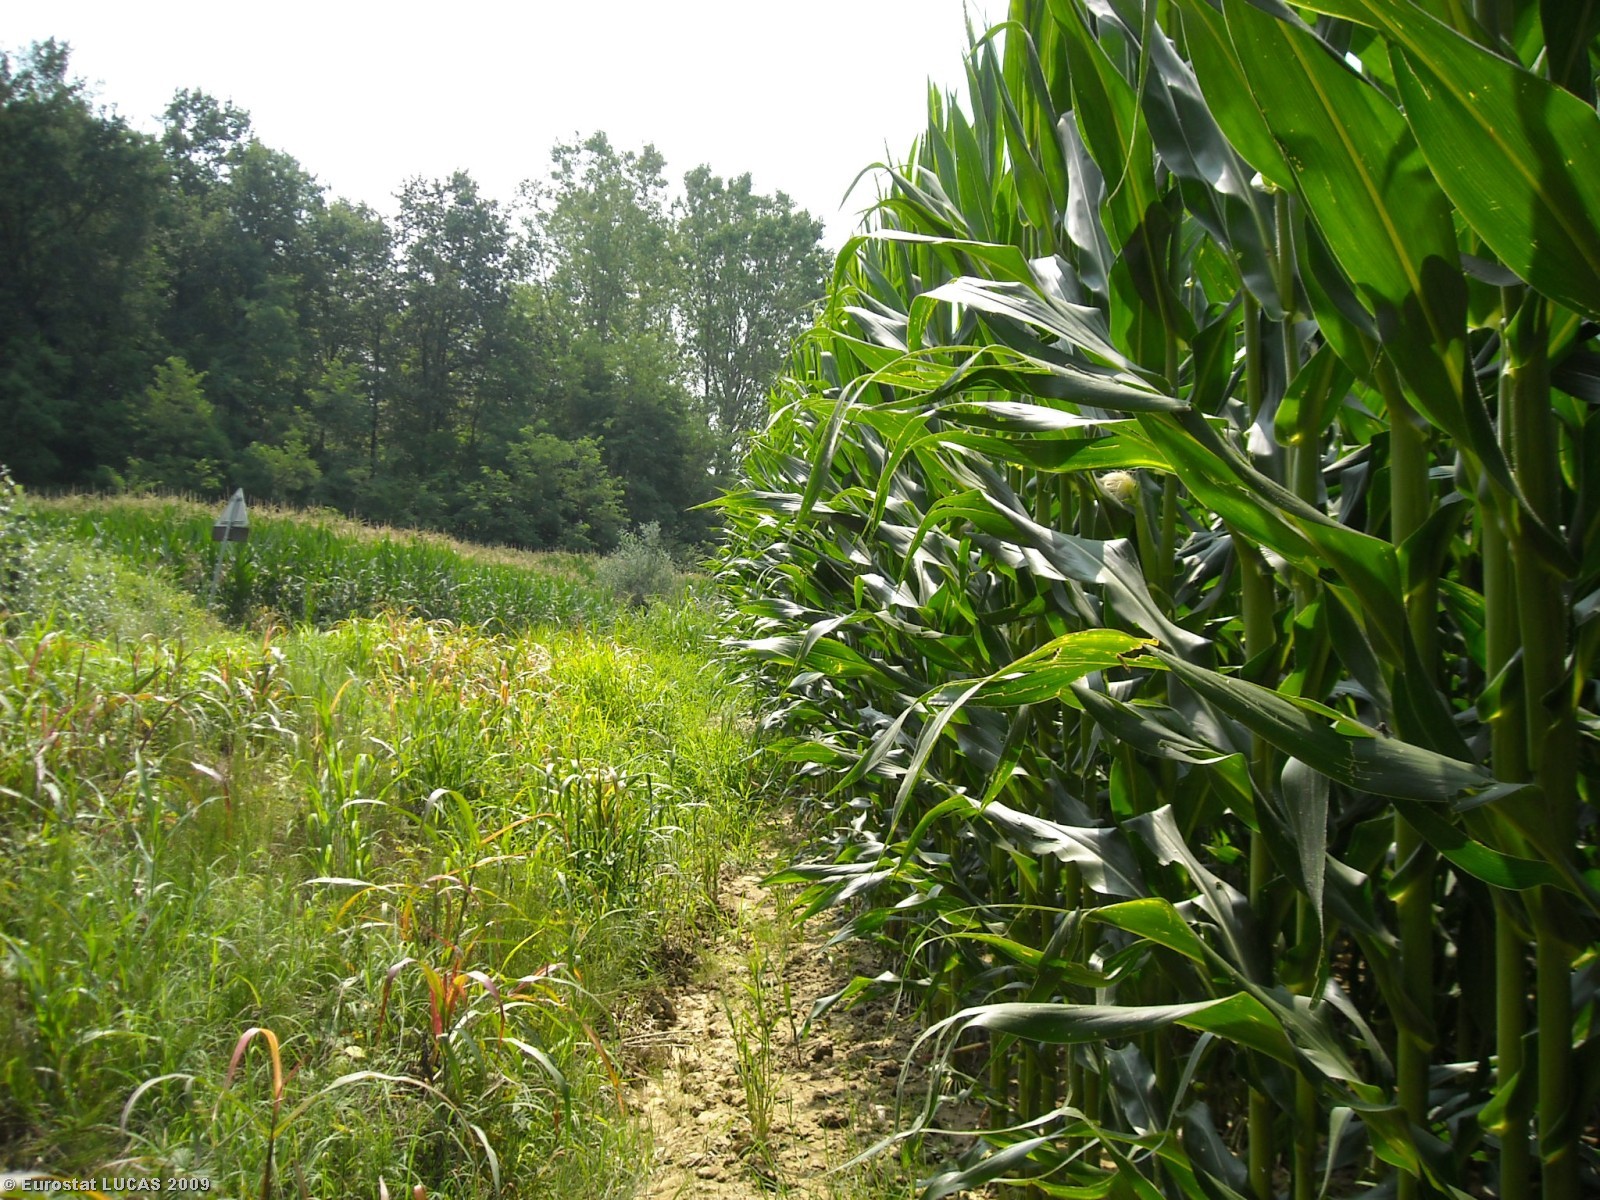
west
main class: Cropland
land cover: Maize
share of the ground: > 75 %
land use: Agriculture (excluding fallow land and kitchen gardens)
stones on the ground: < 10 %
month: July
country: IT
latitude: 44.9643
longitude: 8.0892
